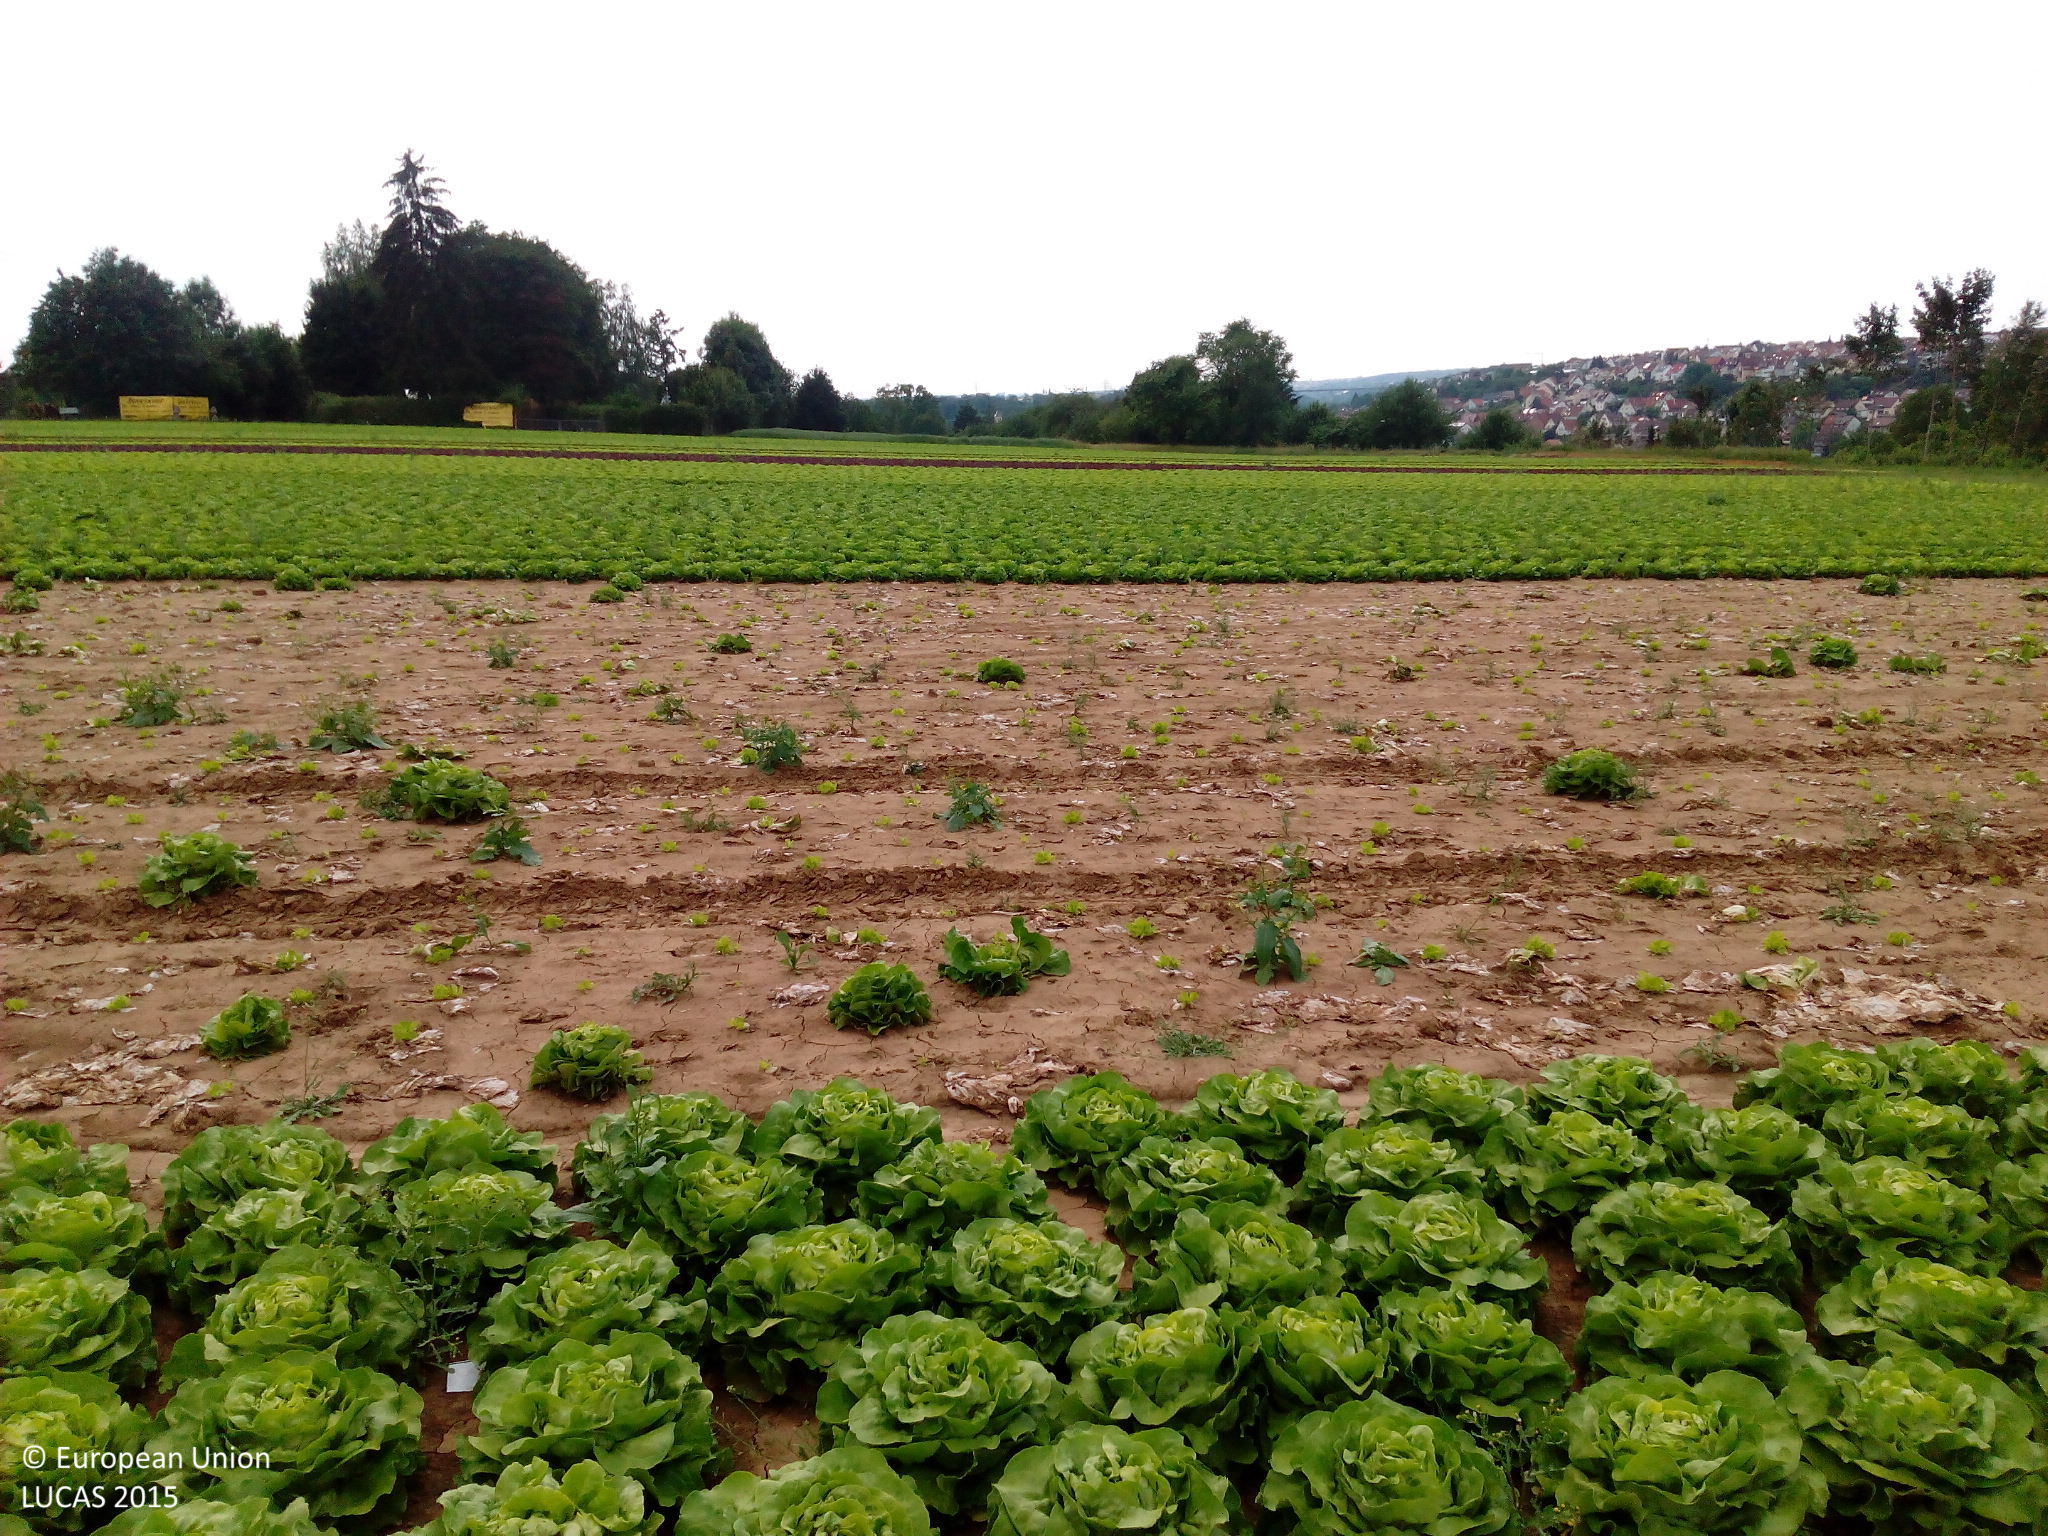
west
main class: Cropland
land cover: Other fresh vegetables
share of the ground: > 75 %
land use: Agriculture (excluding fallow land and kitchen gardens)
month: June
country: DE
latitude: 48.6894
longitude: 9.3347
